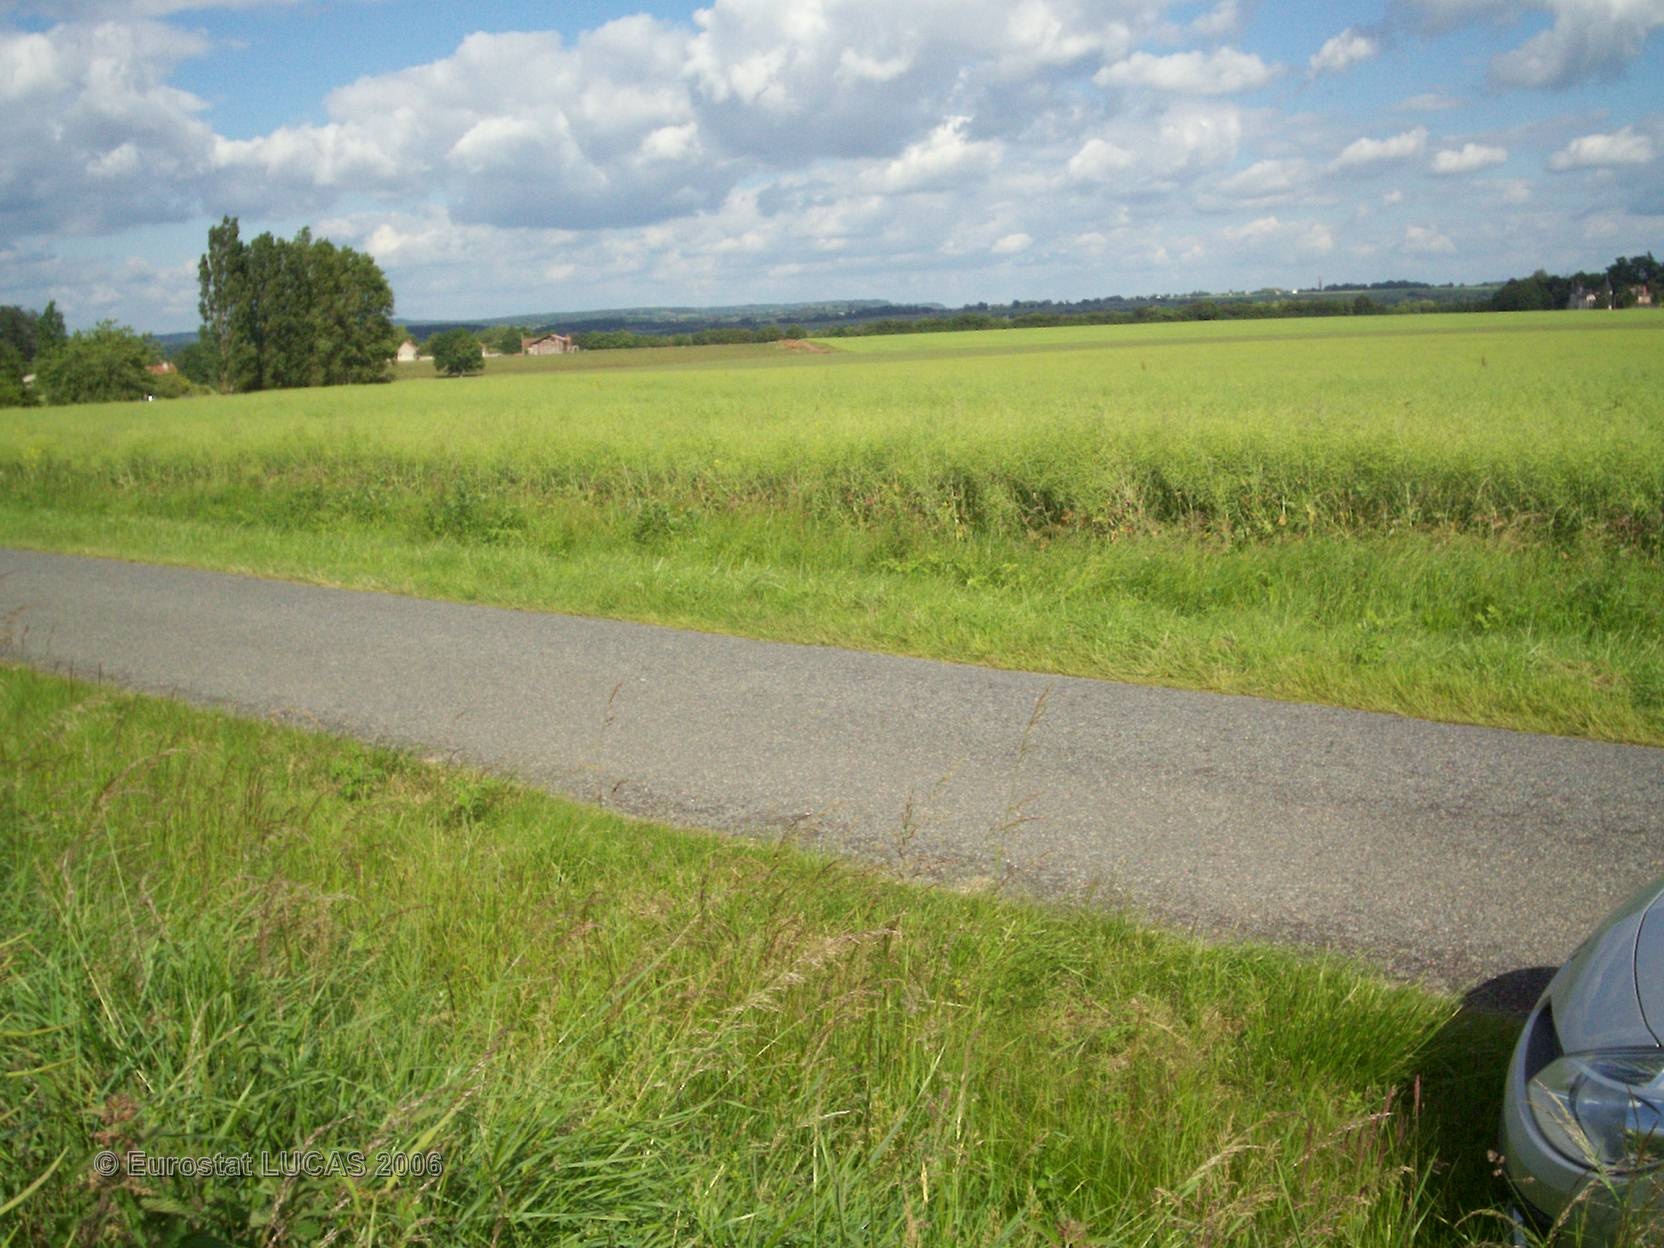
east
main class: Cropland
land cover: Rape and turnip rape
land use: Agriculture (excluding fallow land and kitchen gardens)
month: June
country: FR
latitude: 47.1156
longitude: 2.9970
